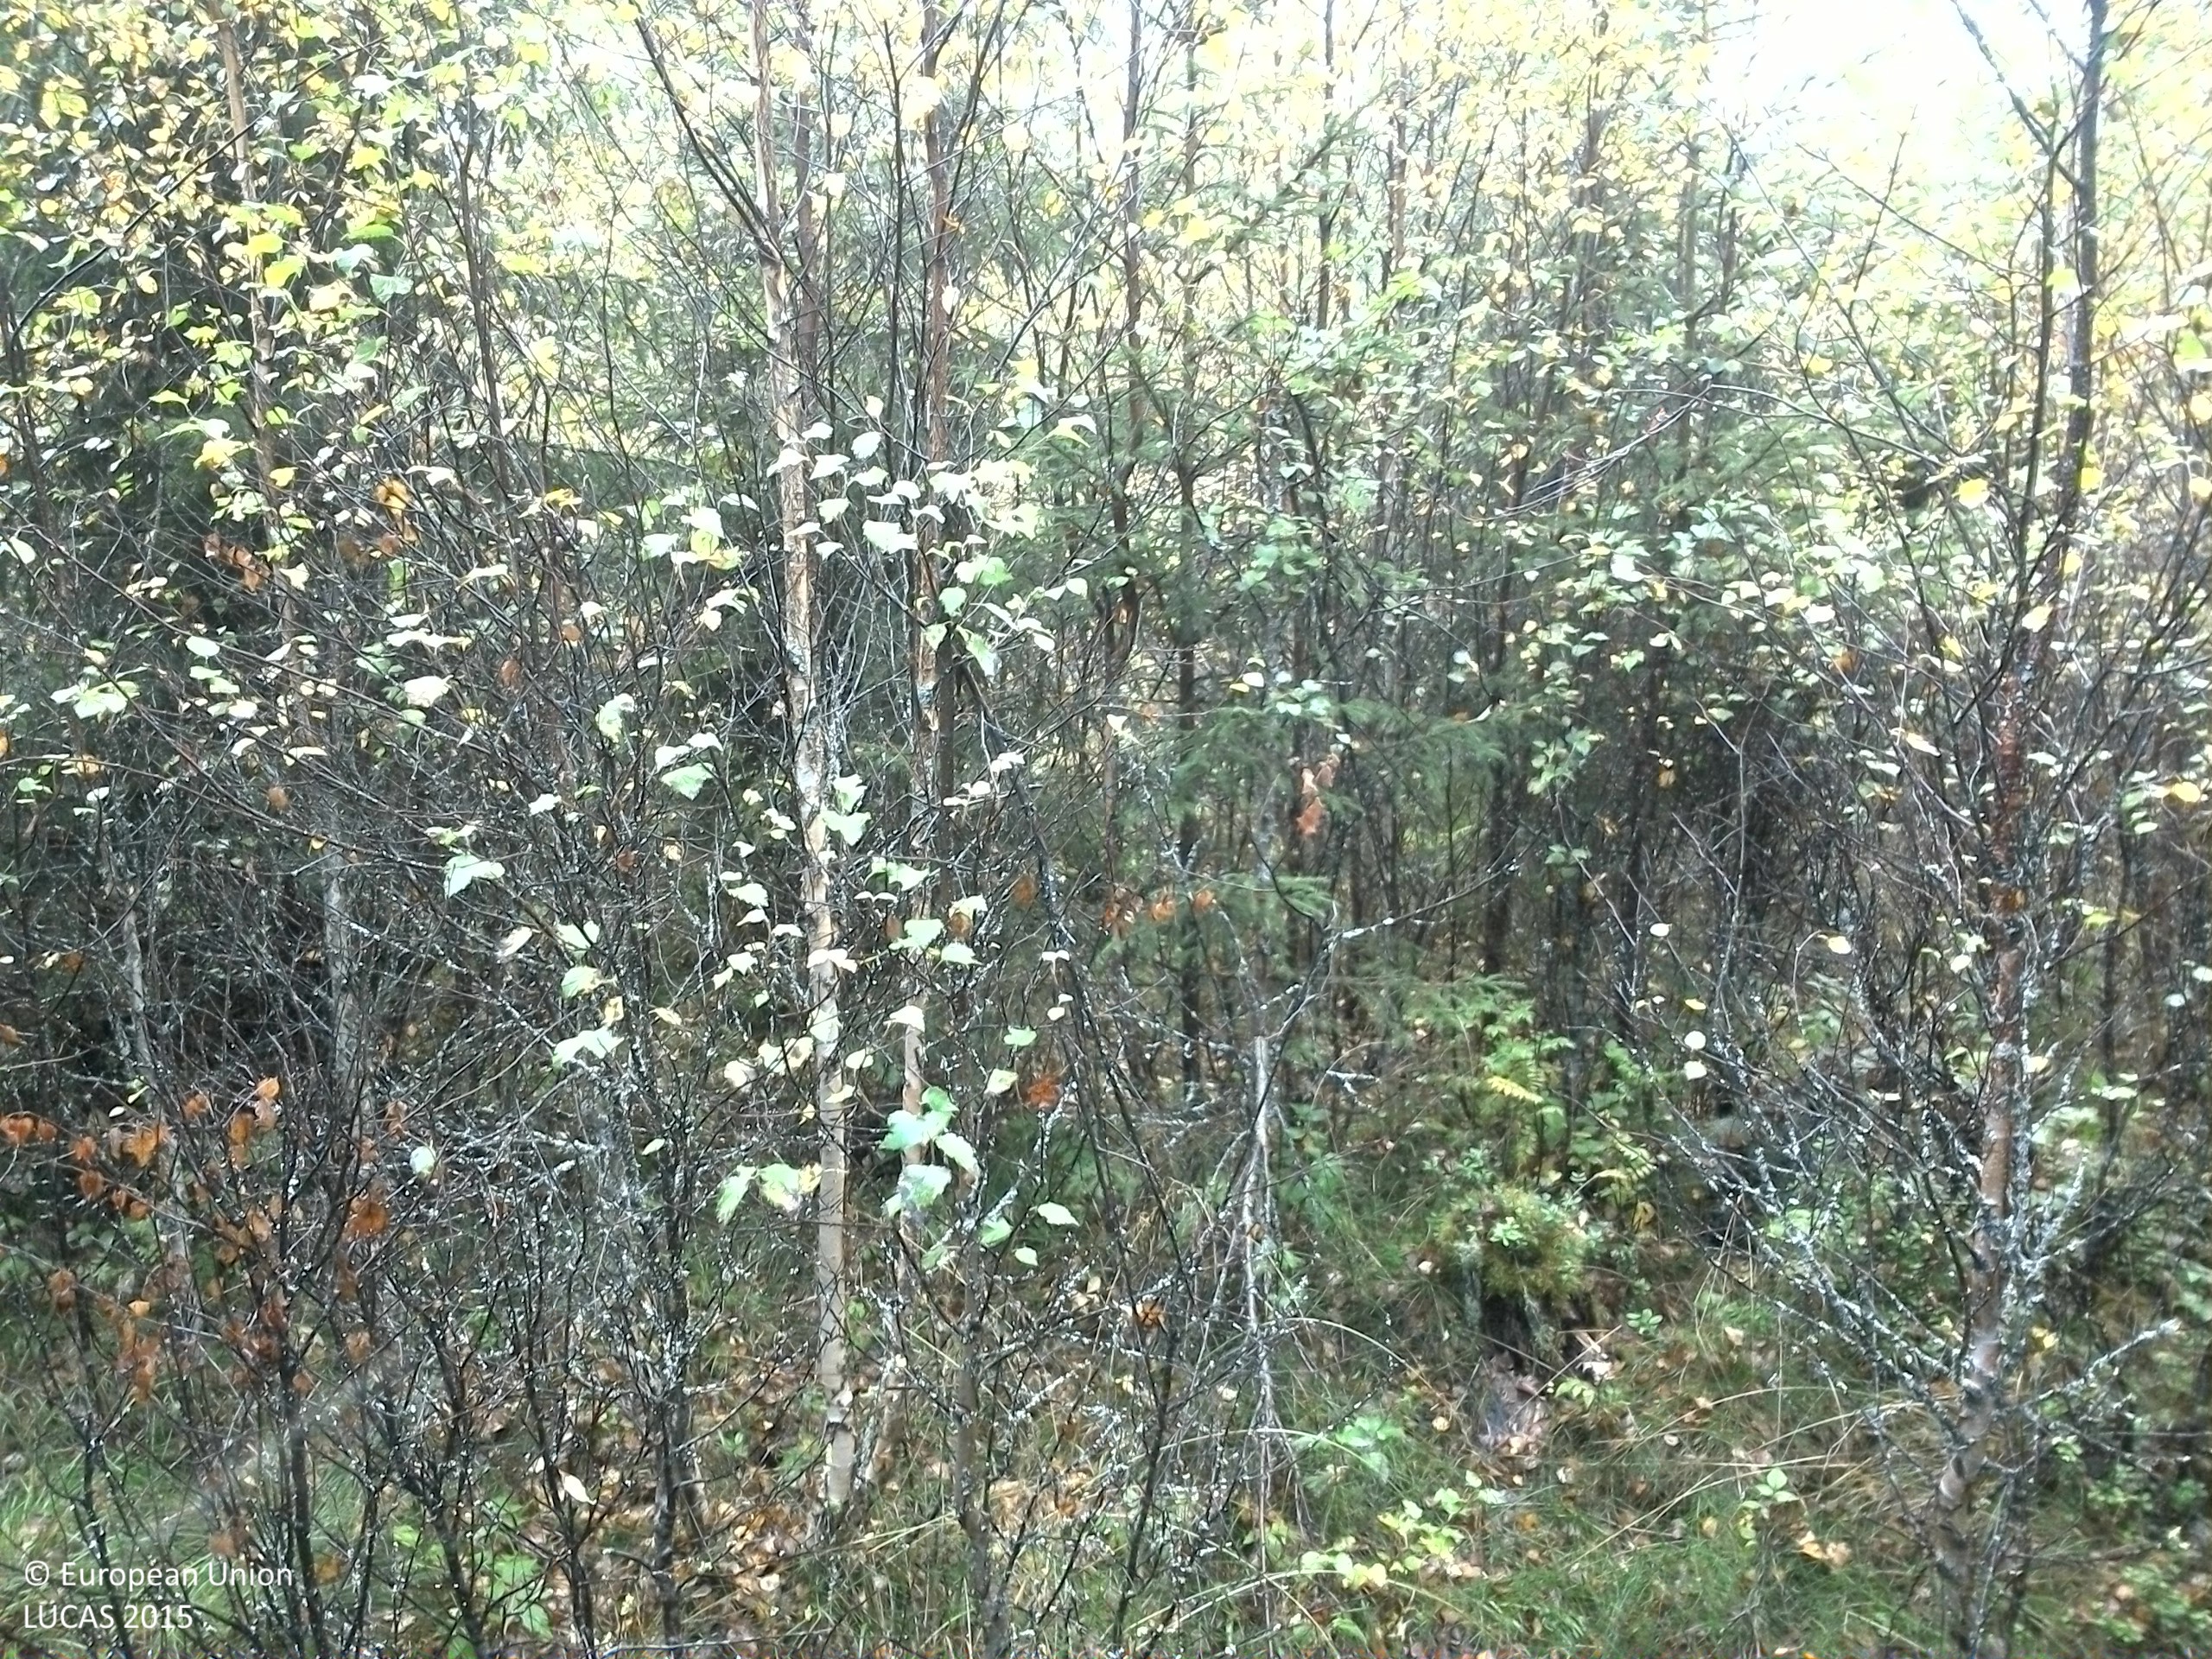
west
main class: Woodland
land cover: Spruce dominated mixed woodland
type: boreal forest
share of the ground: 50 - 75 %
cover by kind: coniferous forest trees 45 %, broadleaved forest trees 25 %, shrubs 15 %, herbaceous plants 15 %
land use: Forestry
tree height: < 5 m
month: September
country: SE
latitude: 61.1753
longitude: 14.9871
